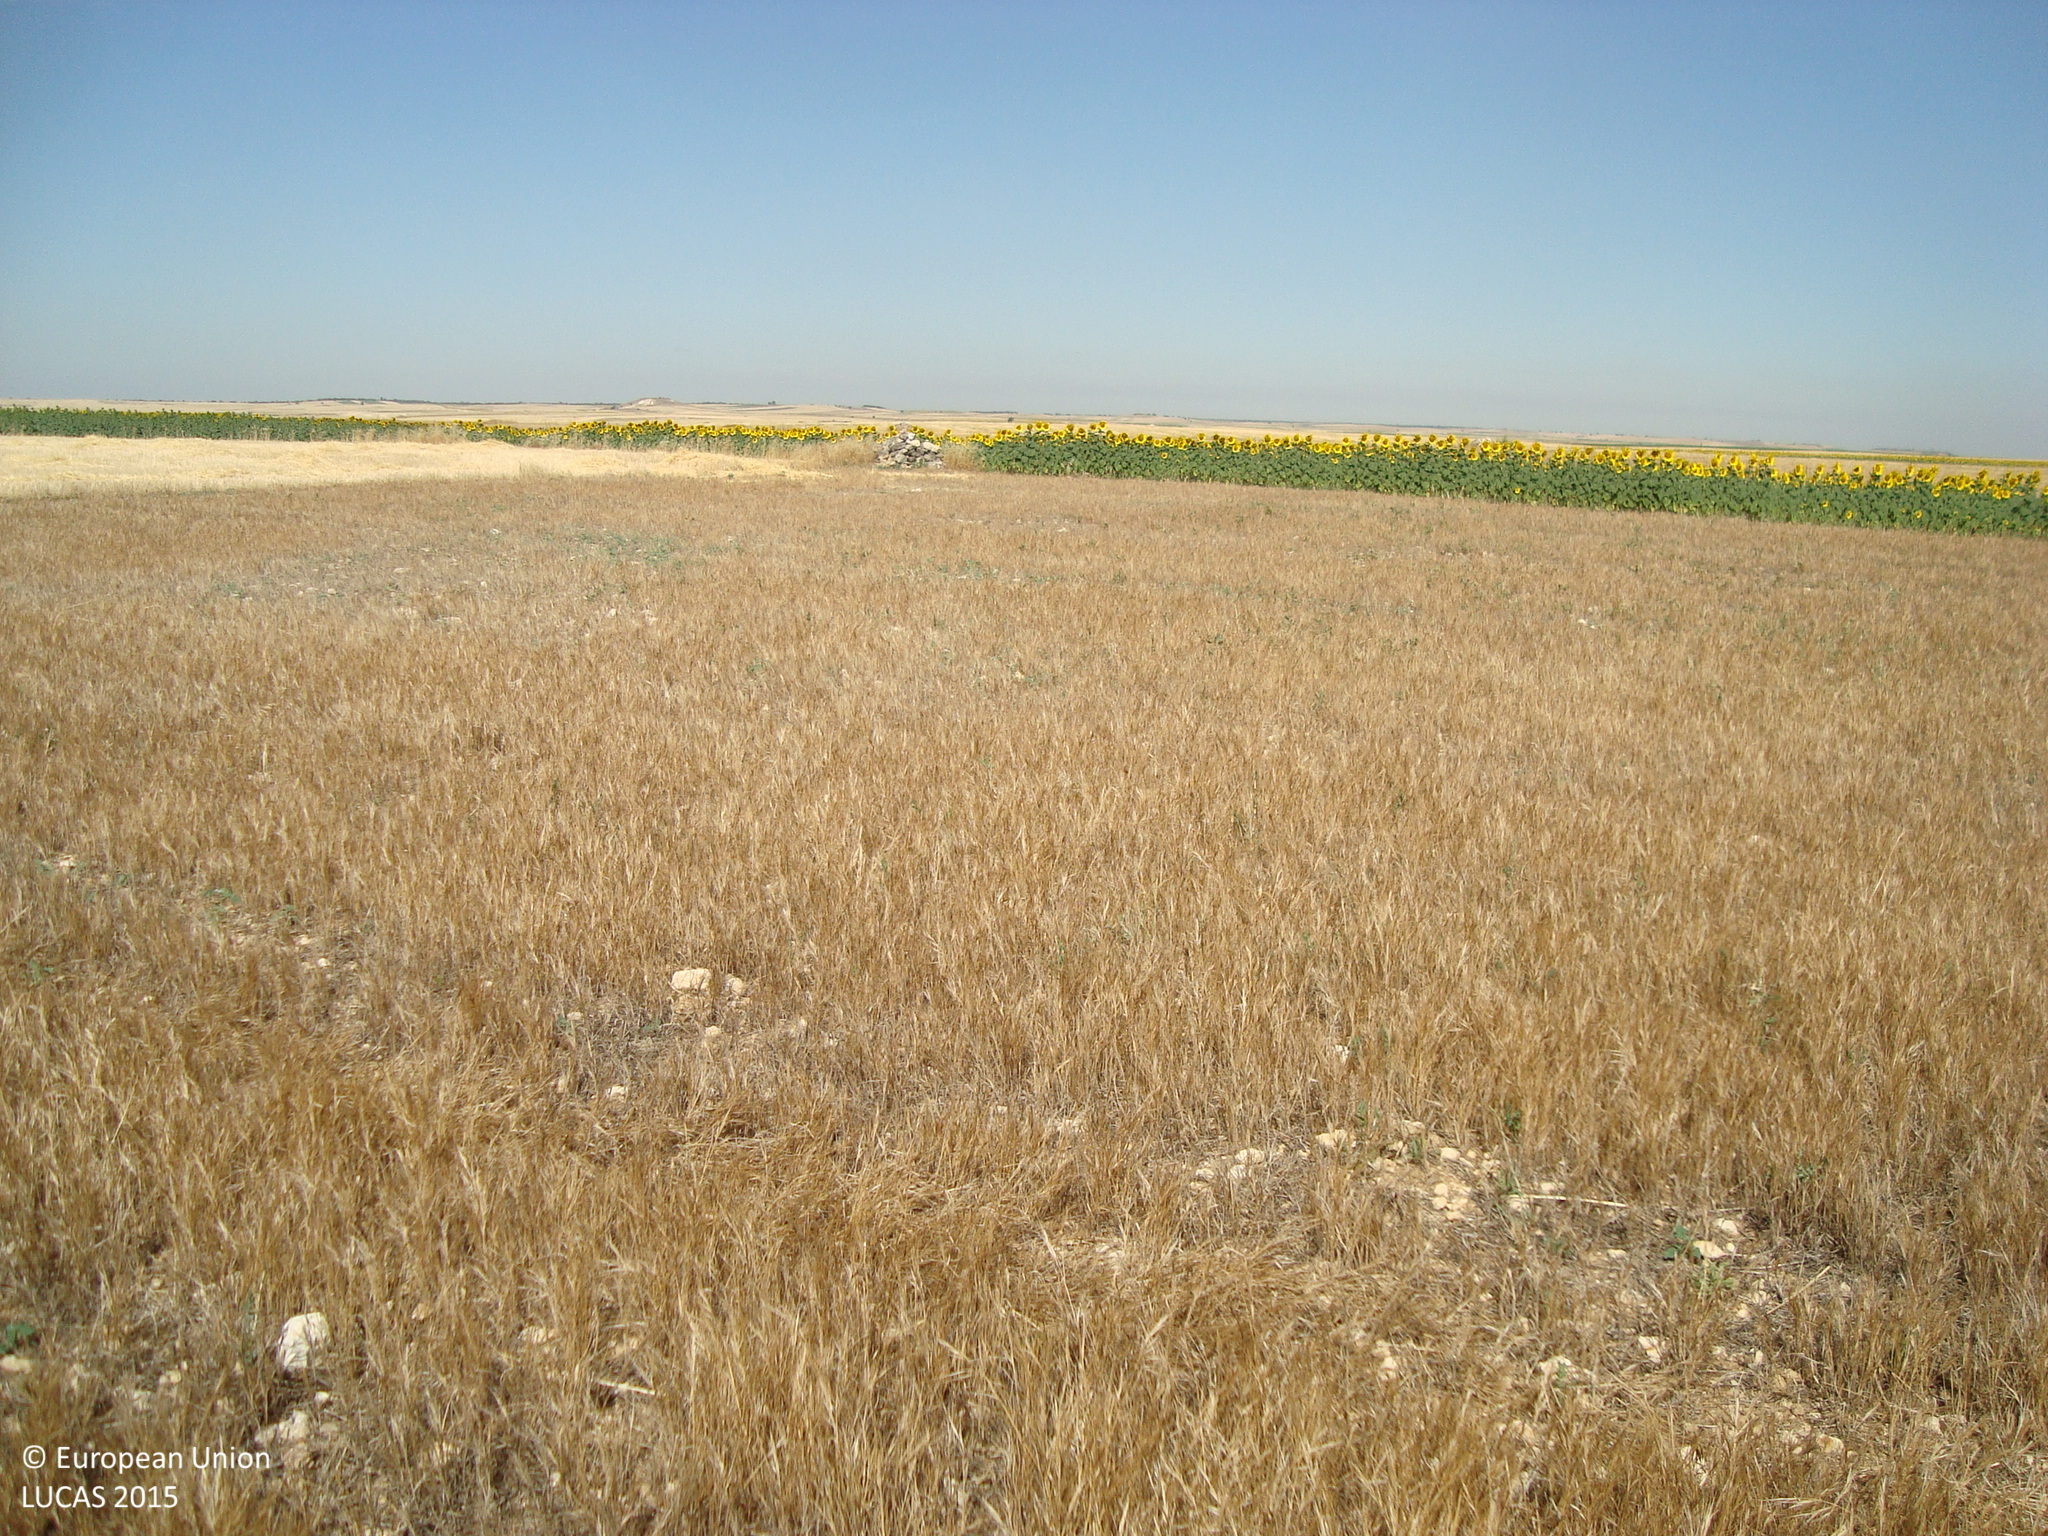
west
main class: Grassland
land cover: Spontaneously vegetated surfaces
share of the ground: > 75 %
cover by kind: herbaceous plants 100 %
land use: Fallow land
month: July
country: ES
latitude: 41.8763
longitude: -3.8788
